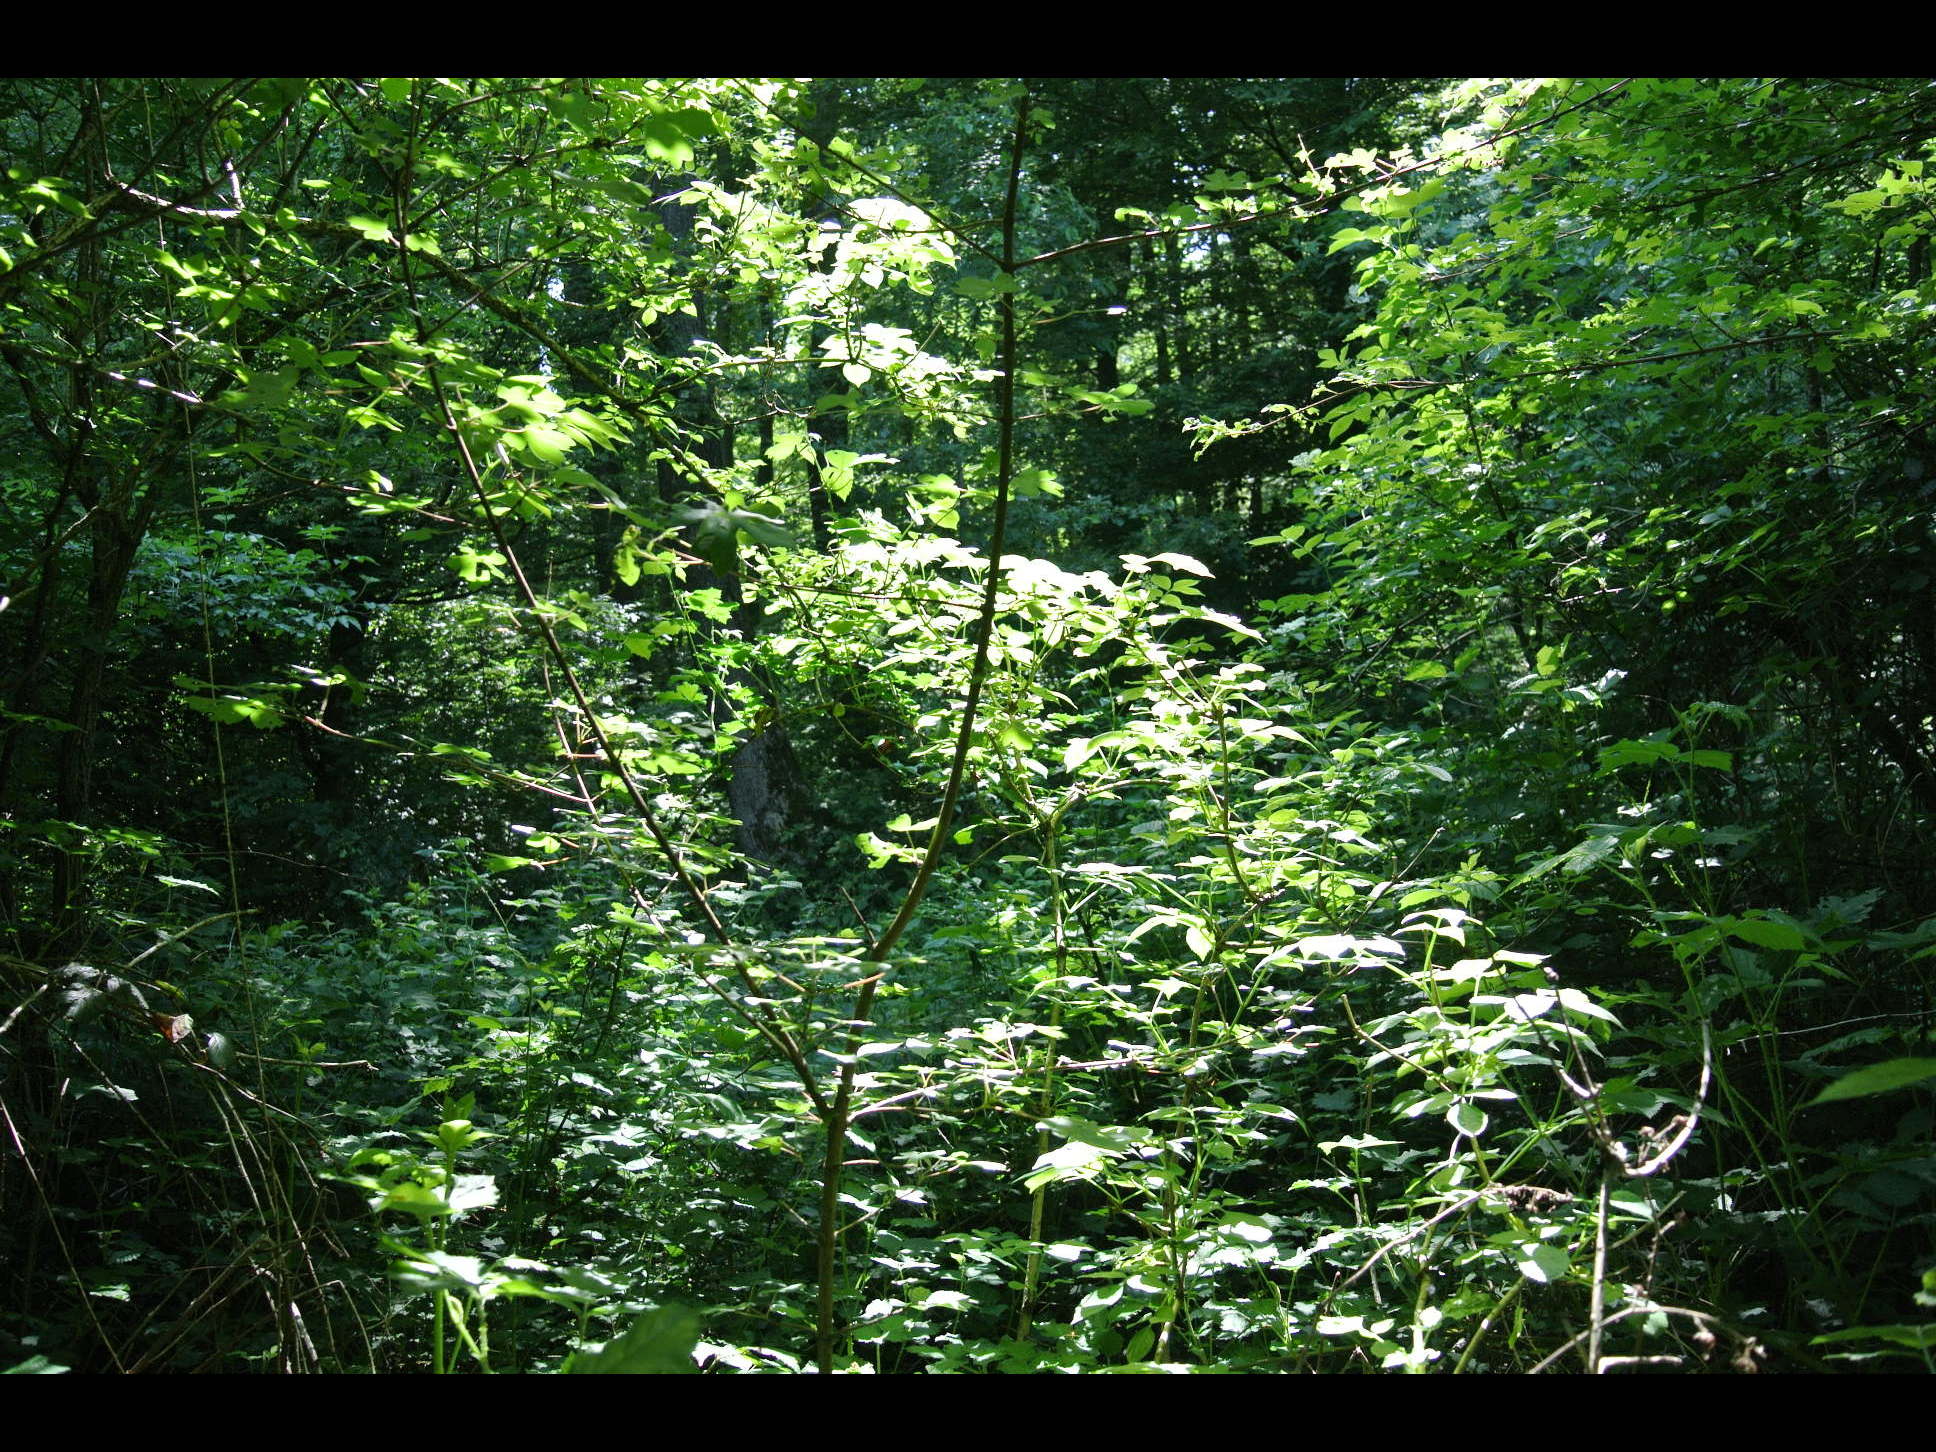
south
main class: Woodland
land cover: Broadleaved woodland
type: mesophytic deciduous forest
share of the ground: > 75 %
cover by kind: broadleaved forest trees 90 %, shrubs 10 %
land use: Forestry
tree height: > 5 m
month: May
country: AT
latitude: 47.9515
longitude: 16.6335
